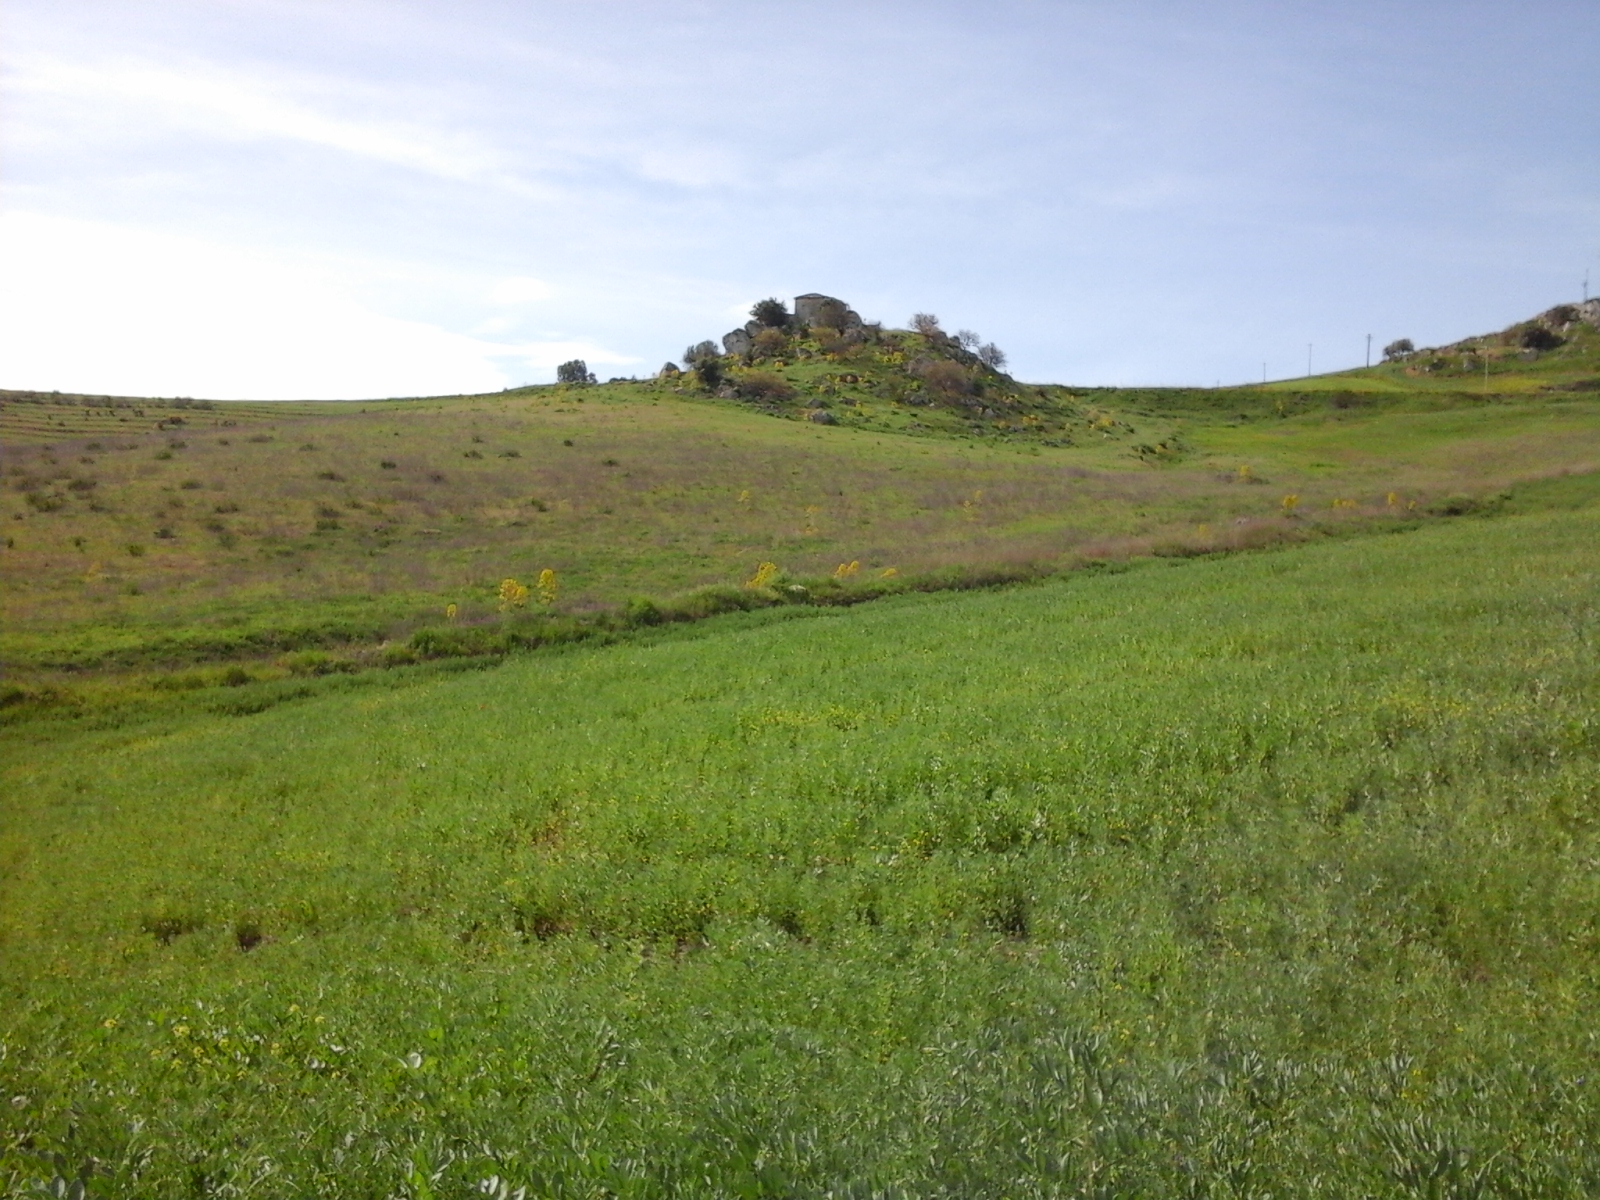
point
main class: Cropland
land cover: Other leguminous and mixtures for fodder
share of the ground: > 75 %
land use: Agriculture (excluding fallow land and kitchen gardens)
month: May
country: IT
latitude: 37.4403
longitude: 14.1170
